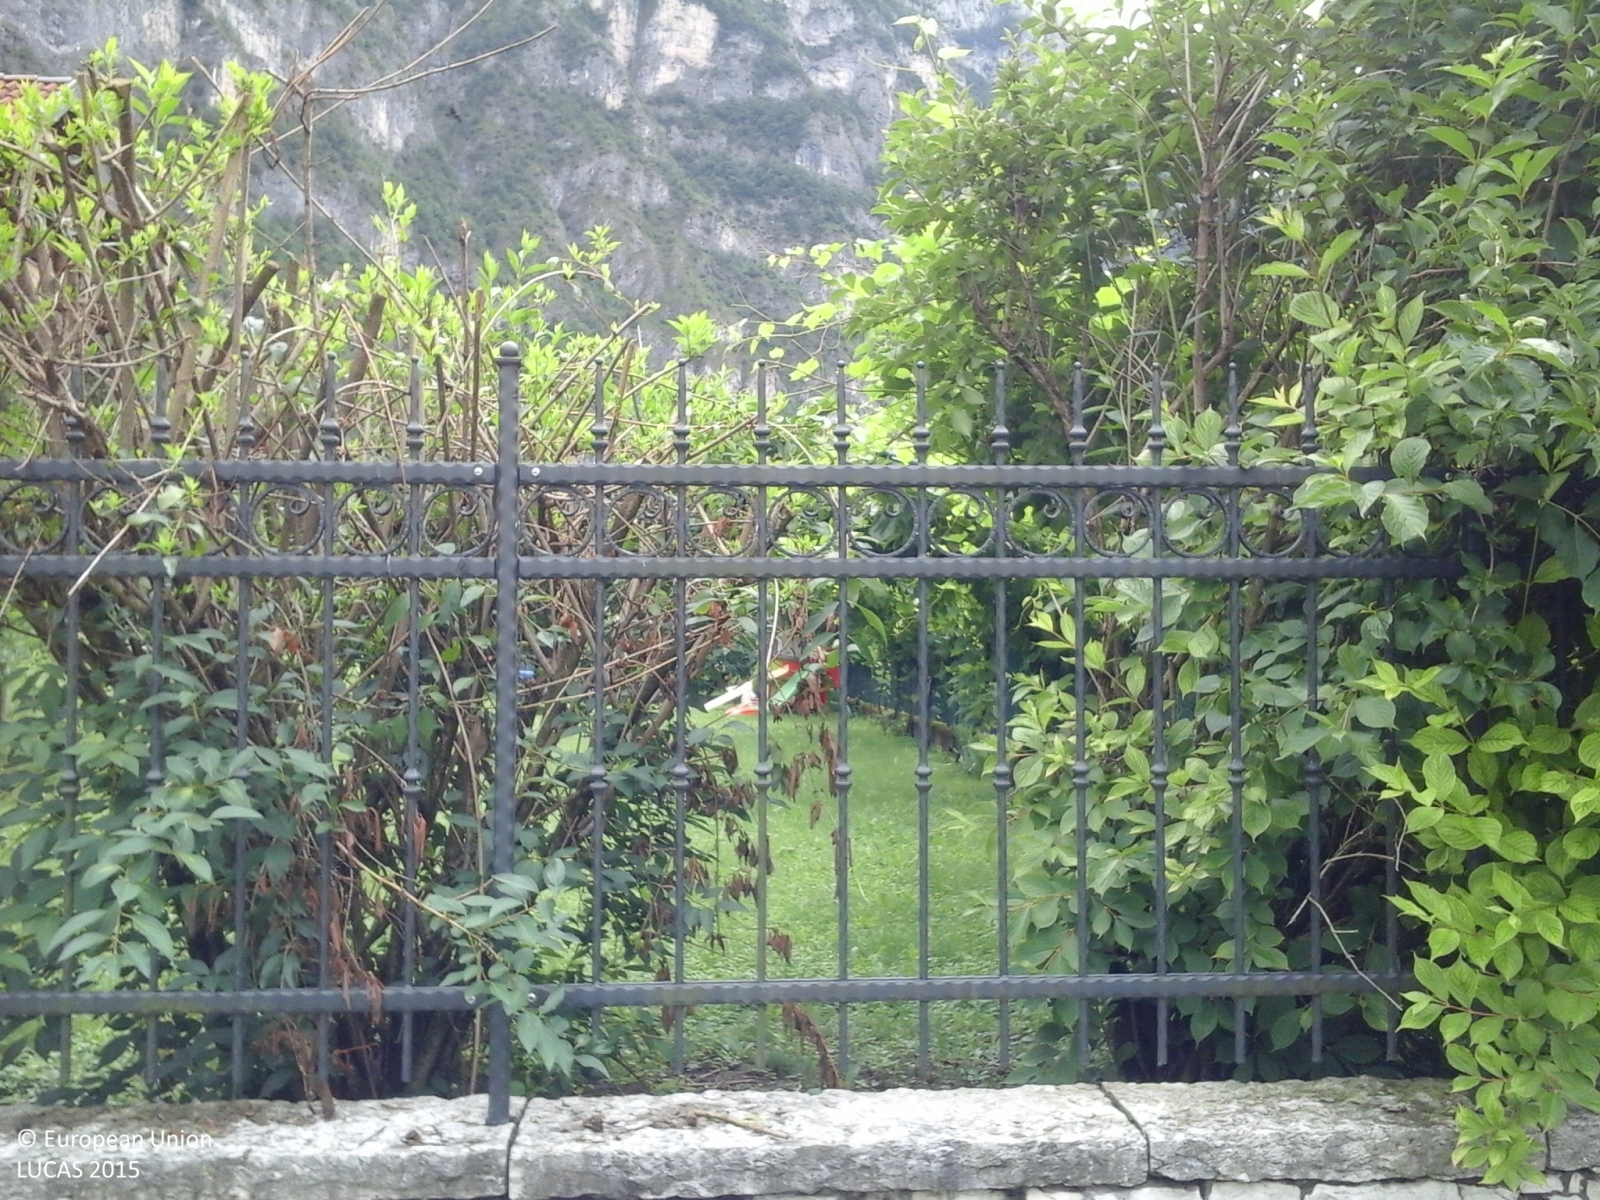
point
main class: Grassland
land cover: Grassland without tree/shrub cover
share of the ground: > 75 %
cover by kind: herbaceous plants 100 %
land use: Residential
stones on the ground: < 10 %
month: June
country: IT
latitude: 46.0144
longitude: 11.6380
